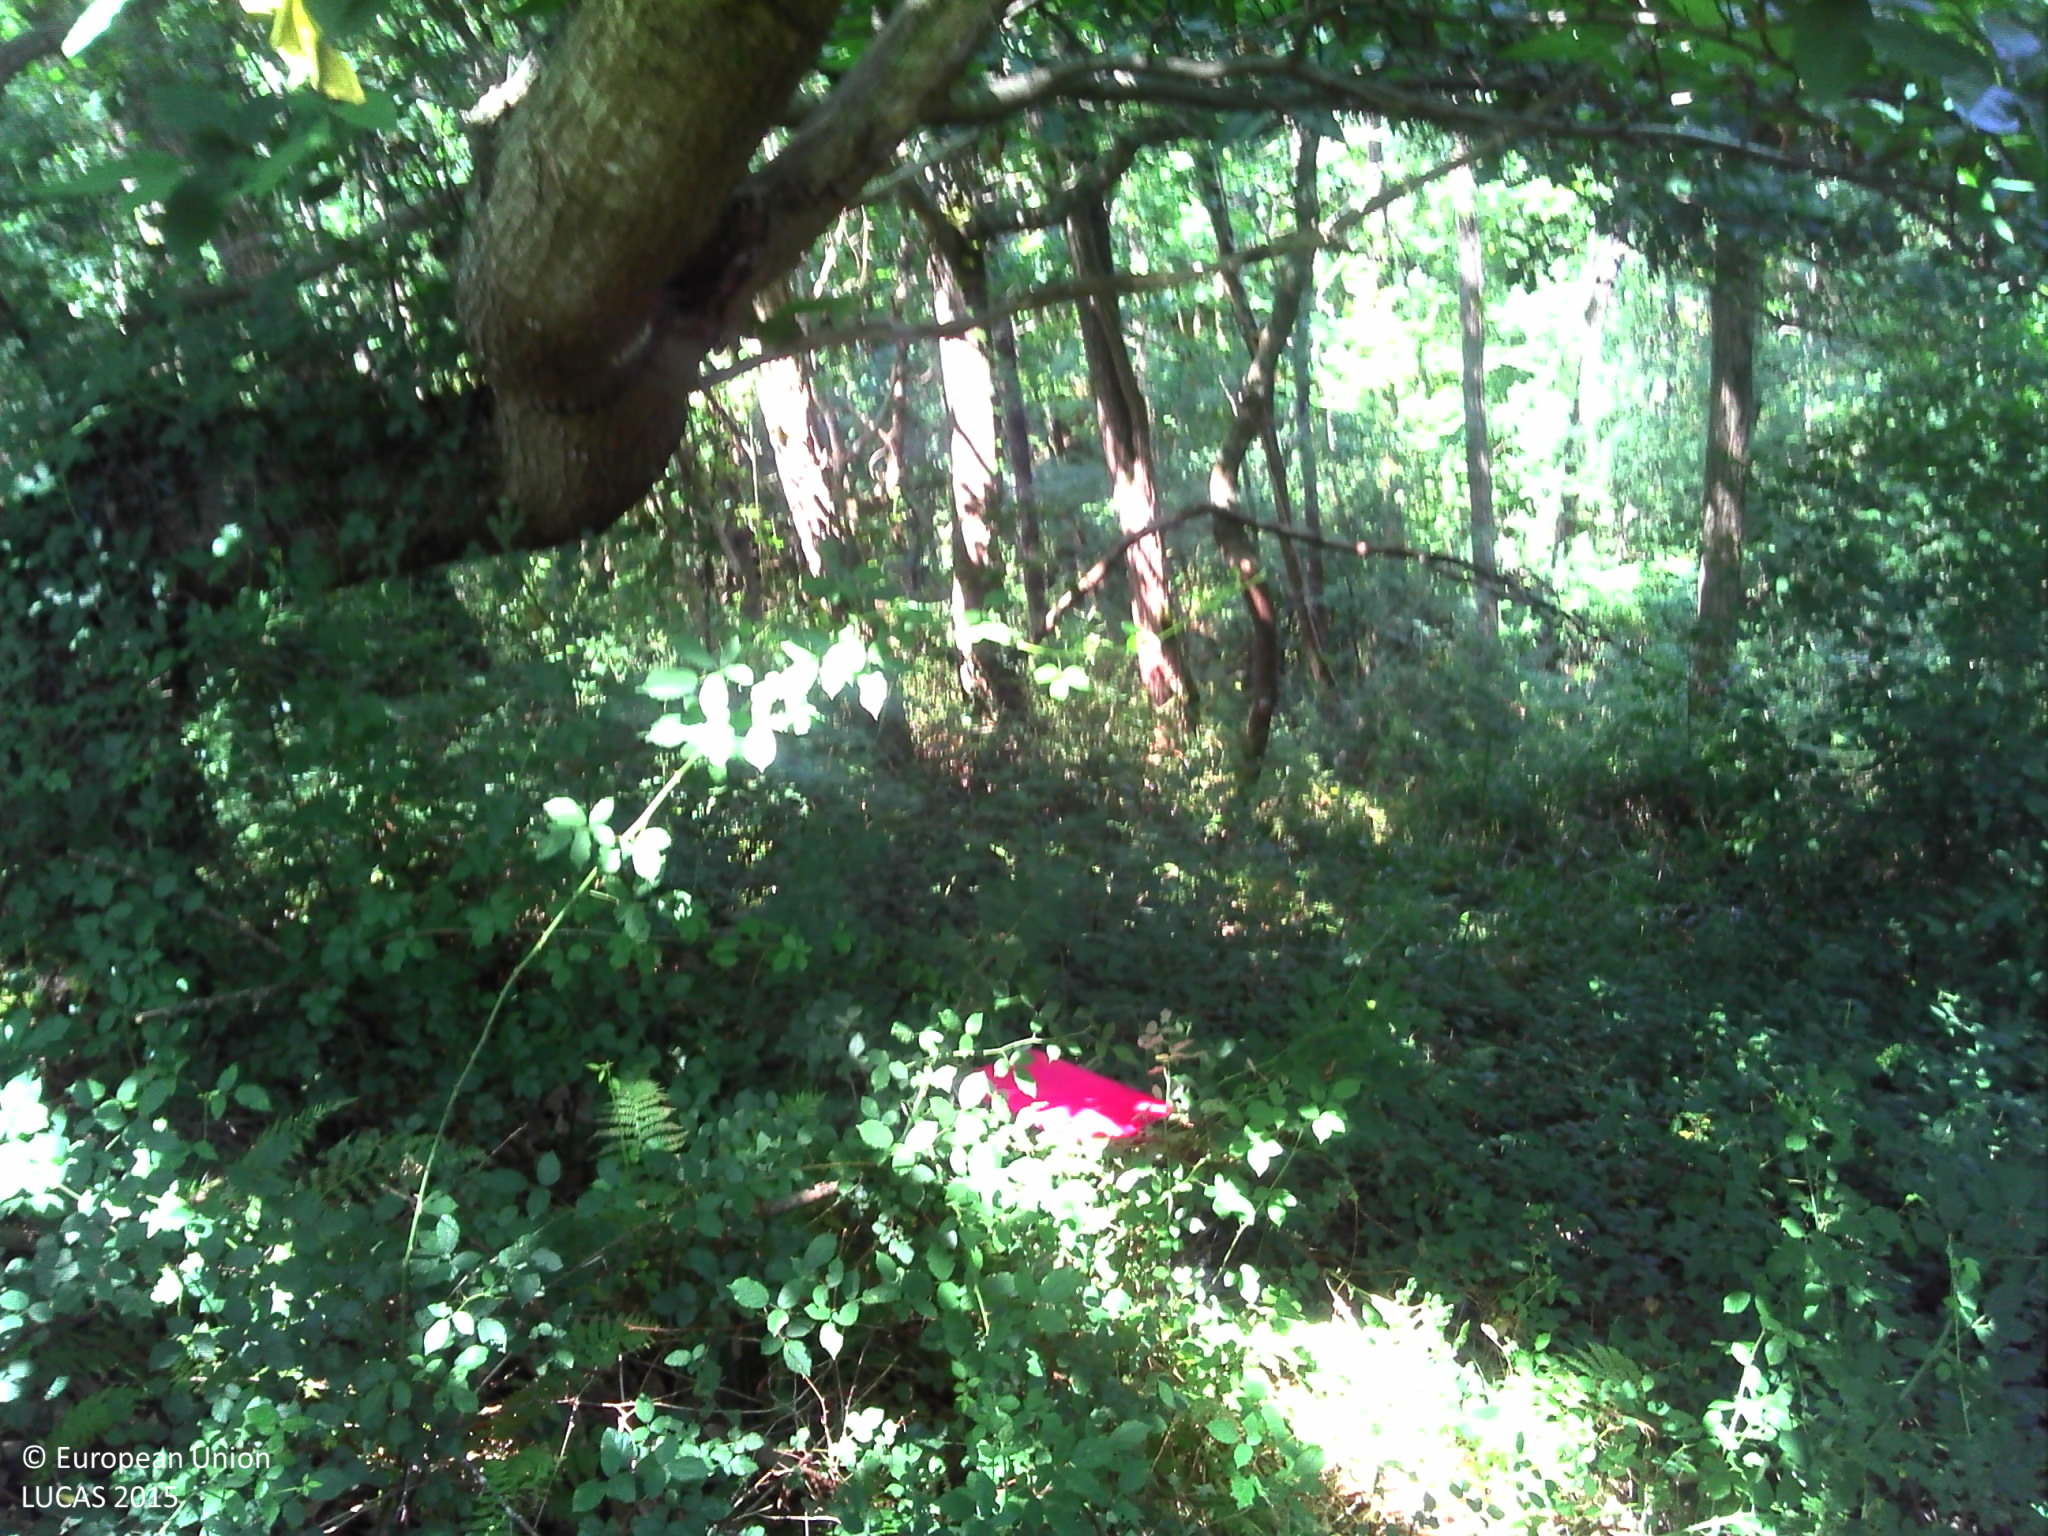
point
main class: Woodland
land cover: Broadleaved woodland
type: thermophilous deciduous forest
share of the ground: > 75 %
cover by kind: broadleaved forest trees 75 %, shrubs 10 %, herbaceous plants 10 %, lichens and mosses 5 %
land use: Forestry
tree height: > 5 m
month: August
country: FR
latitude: 43.3675
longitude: -1.1327
